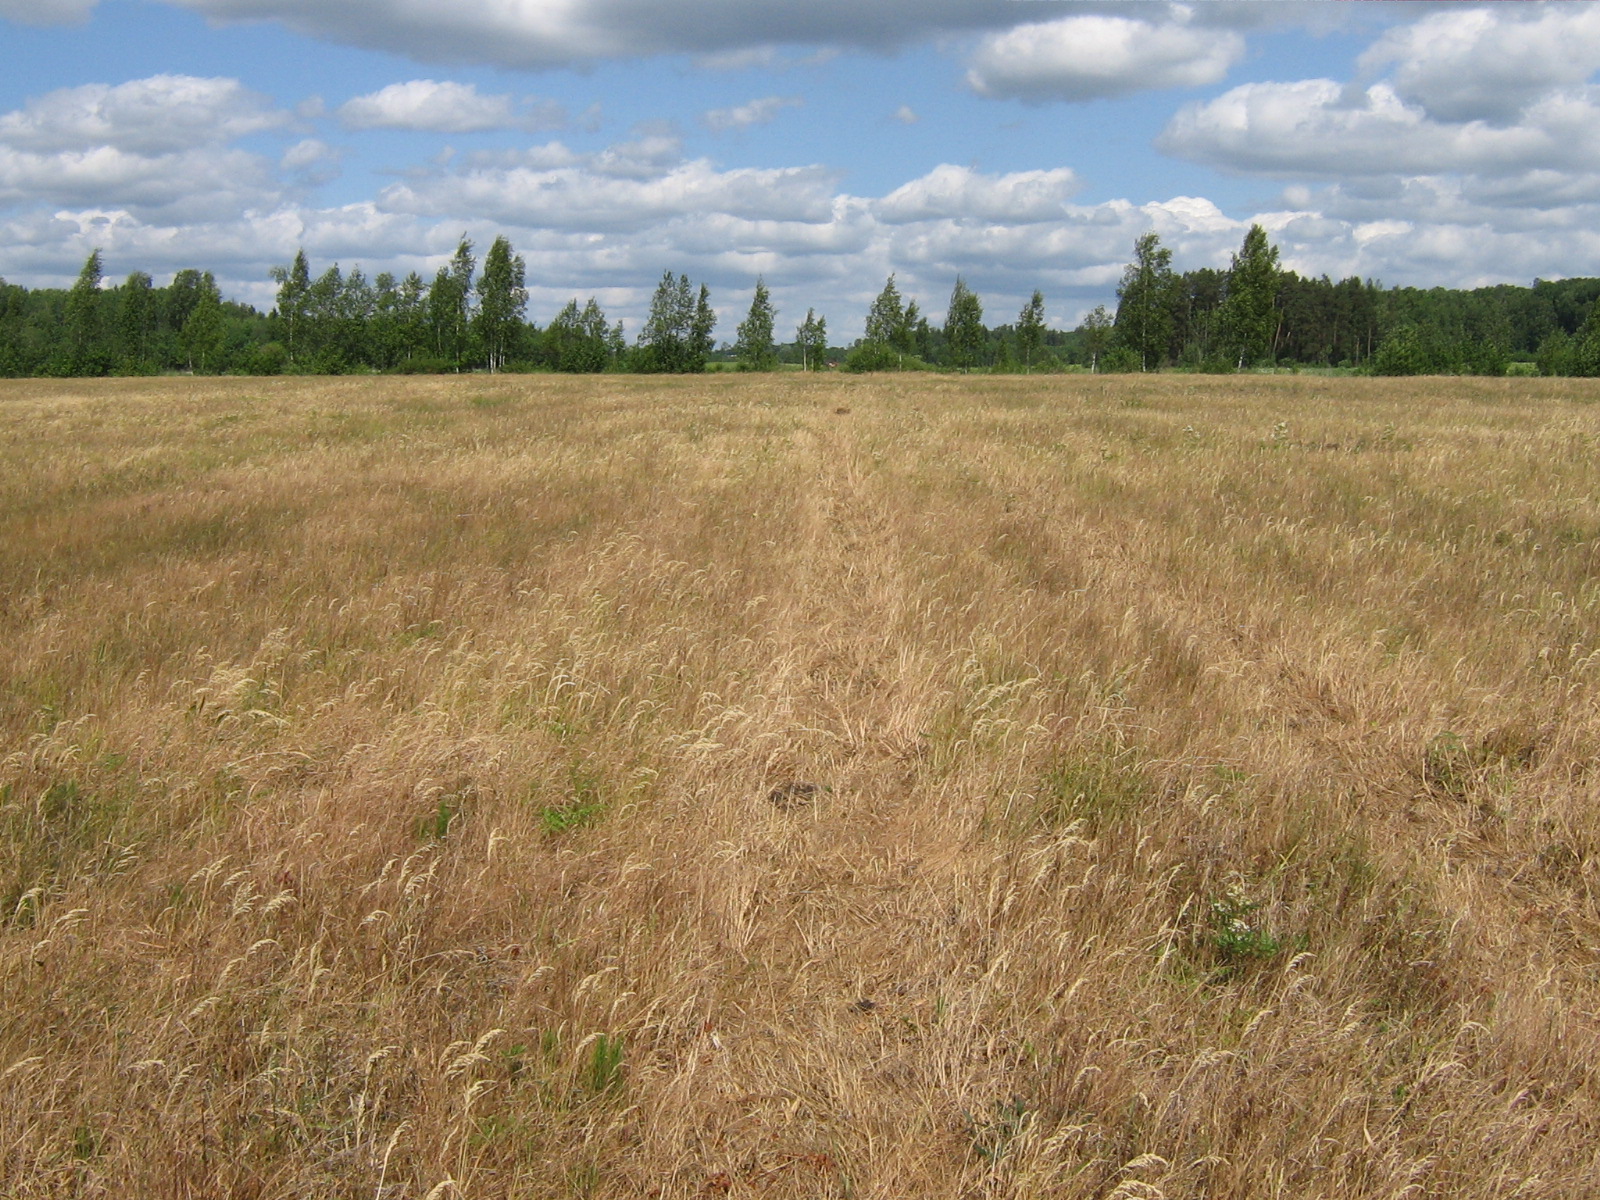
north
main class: Grassland
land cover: Grassland without tree/shrub cover
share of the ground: > 75 %
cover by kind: herbaceous plants 100 %
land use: Agriculture (excluding fallow land and kitchen gardens)
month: June
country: LV
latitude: 56.7032
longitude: 25.5216
